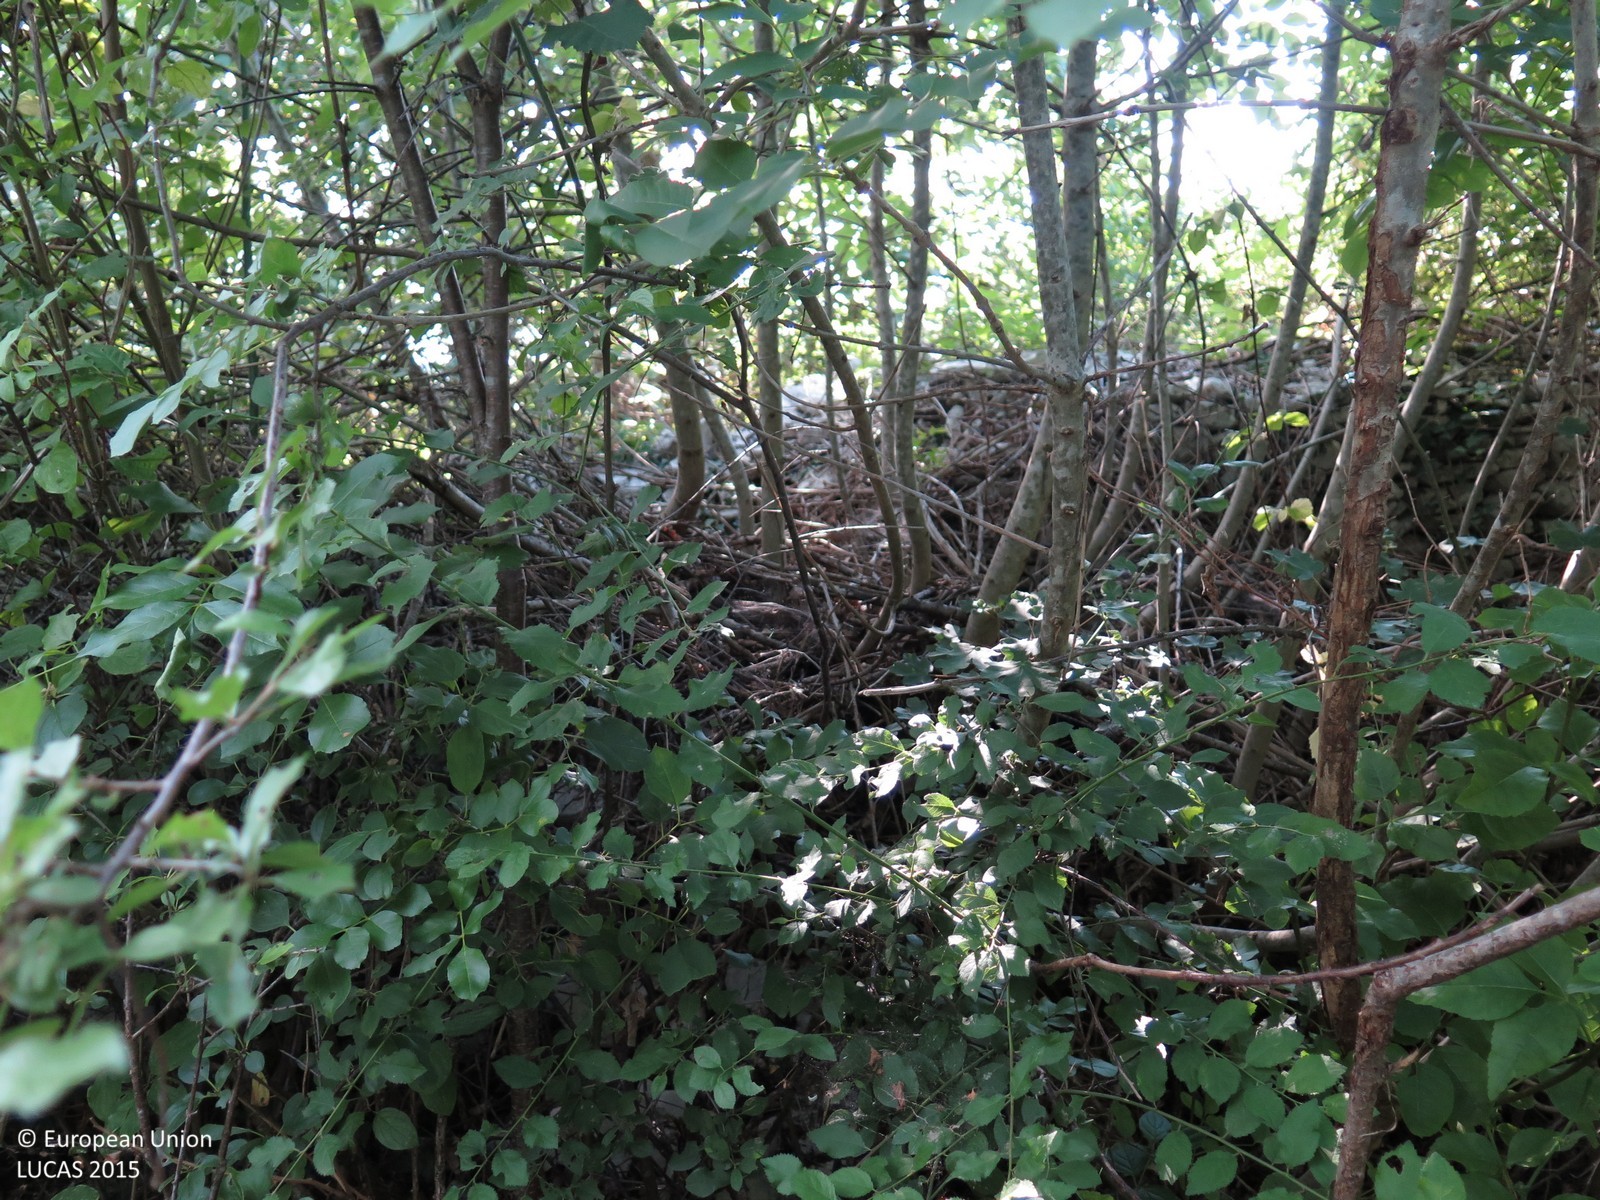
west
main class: Woodland
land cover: Broadleaved woodland
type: mesophytic deciduous forest
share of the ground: > 75 %
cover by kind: broadleaved forest trees 95 %, shrubs 5 %
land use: Semi-natural and natural areas not in use
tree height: > 5 m
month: June
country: HR
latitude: 45.1456
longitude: 13.8482
